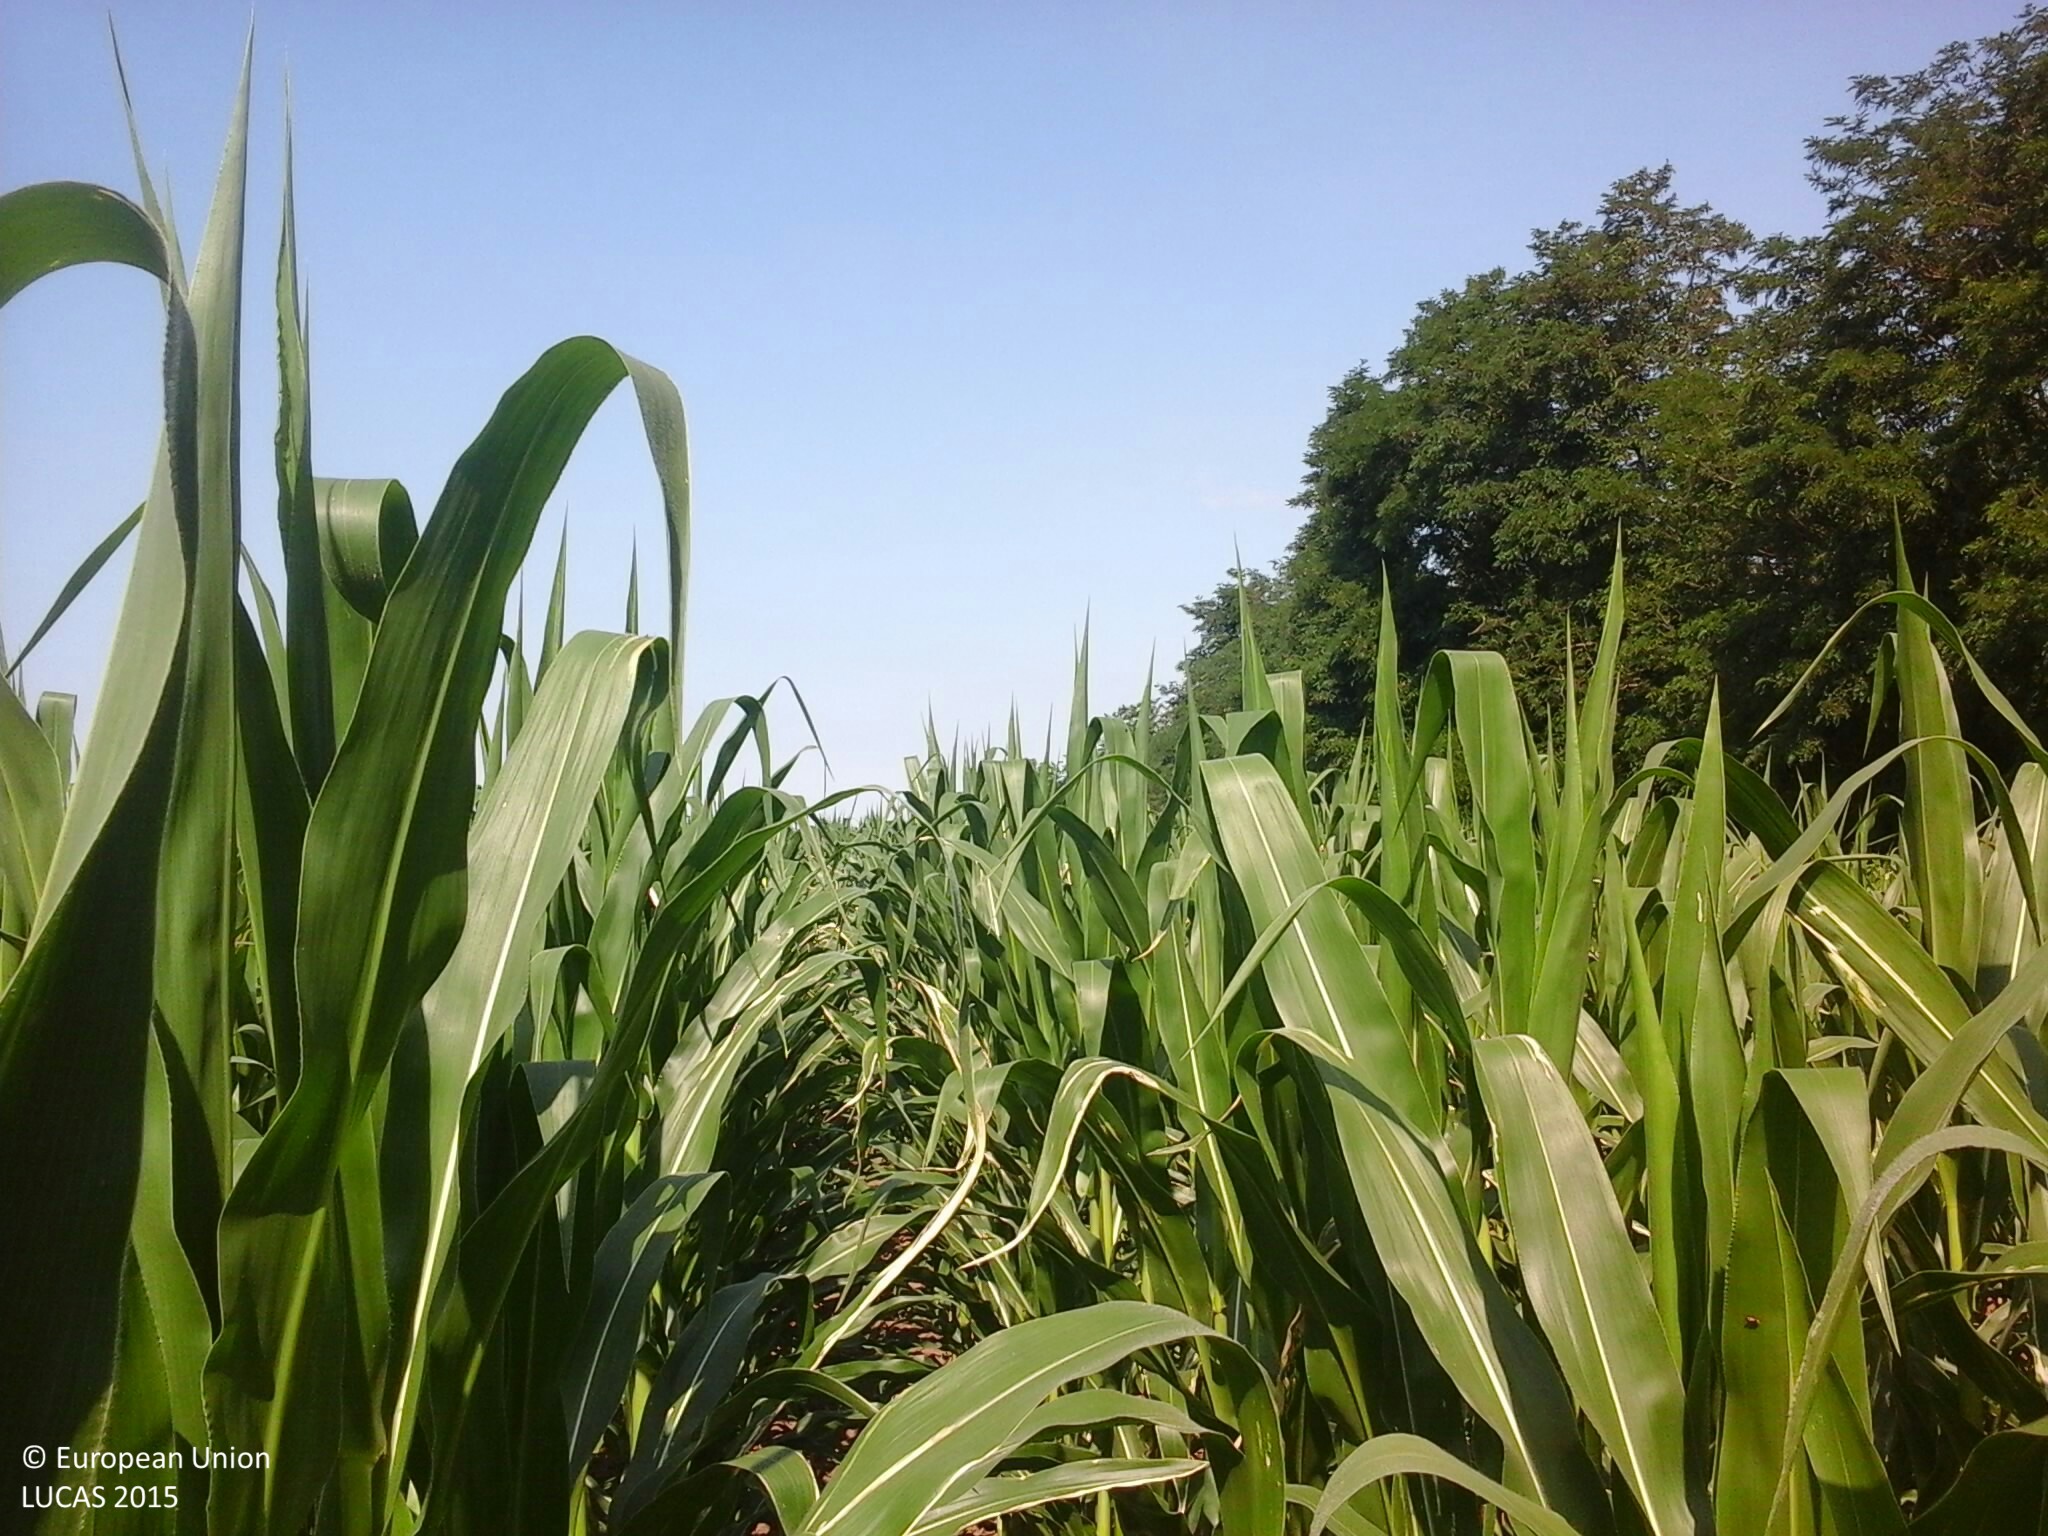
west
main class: Cropland
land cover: Maize
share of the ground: 50 - 75 %
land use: Agriculture (excluding fallow land and kitchen gardens)
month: July
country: HU
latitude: 47.8986
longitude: 21.7796
